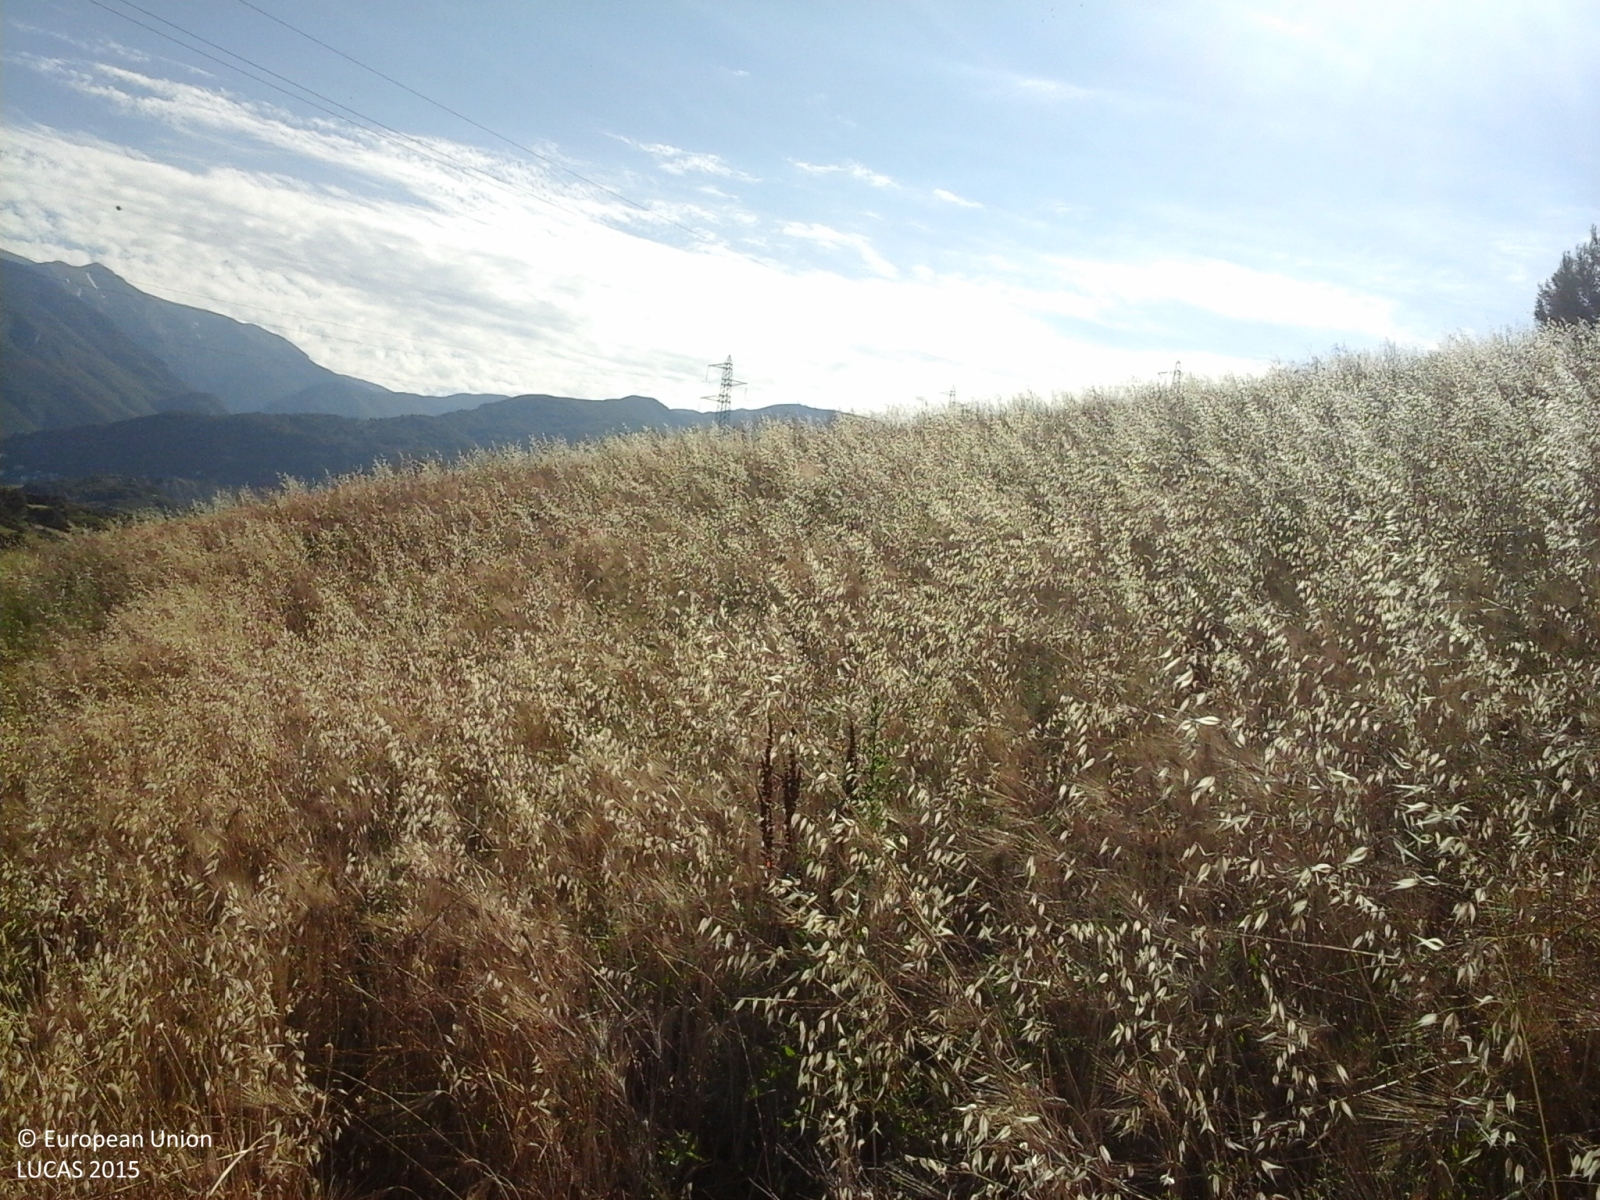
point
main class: Cropland
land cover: Durum wheat
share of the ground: > 75 %
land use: Agriculture (excluding fallow land and kitchen gardens)
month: June
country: IT
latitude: 42.1856
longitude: 14.2366
